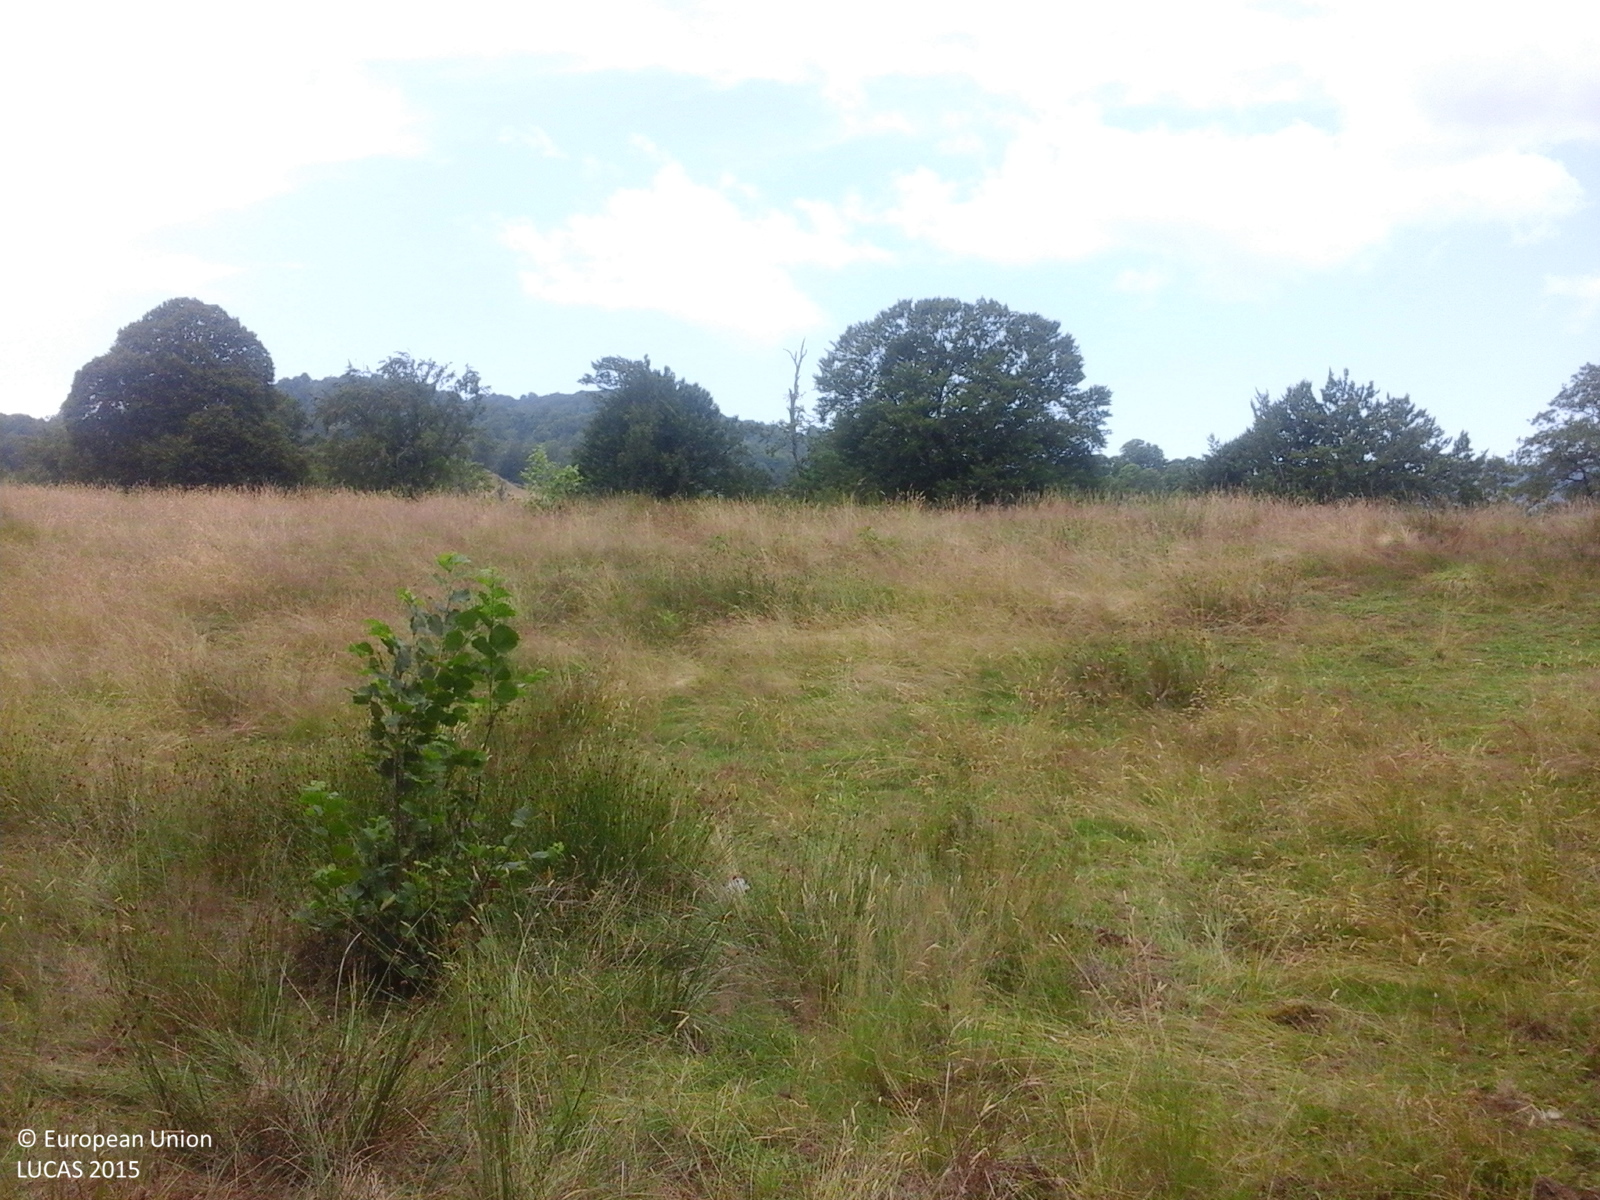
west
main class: Woodland
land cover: Broadleaved woodland
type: beech forest
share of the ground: > 75 %
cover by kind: broadleaved forest trees 100 %
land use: Forestry
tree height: > 5 m
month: July
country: RO
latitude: 45.3510
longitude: 24.8013
